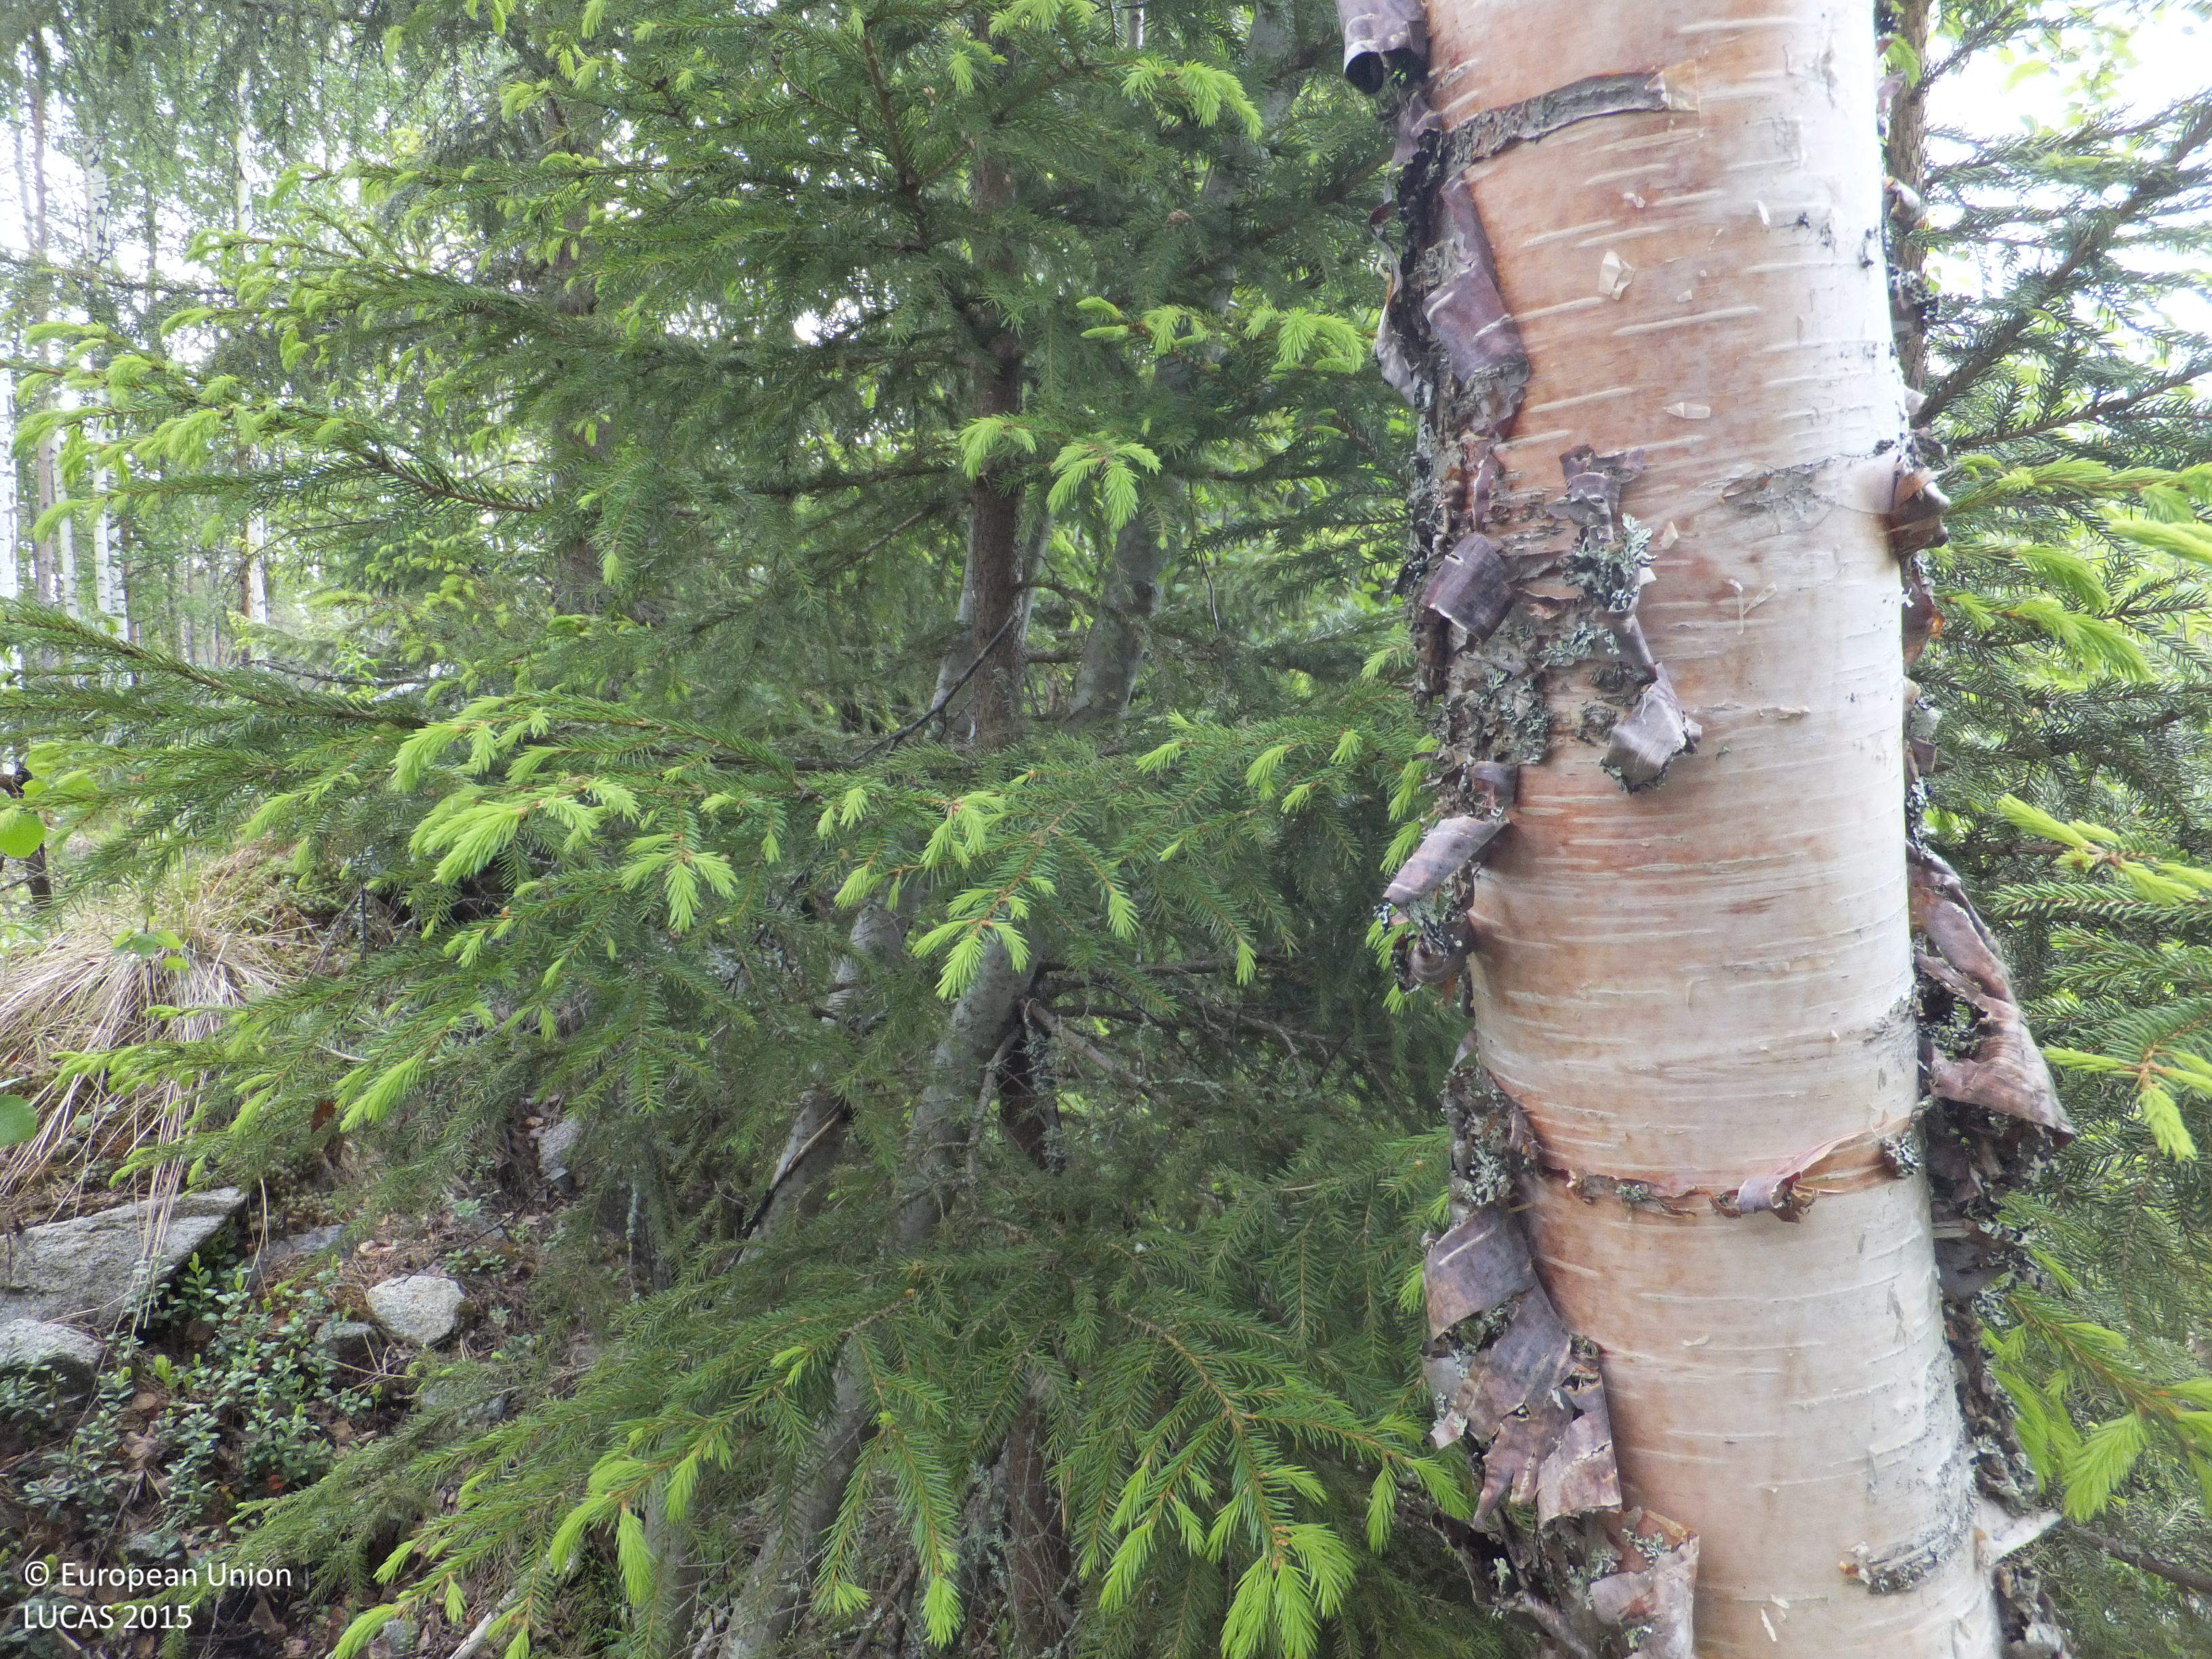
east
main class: Woodland
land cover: Other mixed woodland
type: boreal forest
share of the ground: 50 - 75 %
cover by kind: coniferous forest trees 35 %, broadleaved forest trees 35 %, shrubs 20 %, herbaceous plants 5 %, lichens and mosses 5 %
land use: Forestry
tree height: > 5 m
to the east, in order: Other mixed woodland; Ditches and canals; Pine dominated mixed woodland; Pine dominated coniferous woodland; Ditches and canals; Pine dominated coniferous woodland; Ditches and canals; Pine dominated coniferous woodland; Ditches and canals; Pine dominated coniferous woodland; Ditches and canals; Pine dominated coniferous woodland
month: June
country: FI
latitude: 63.6433
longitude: 24.8023
